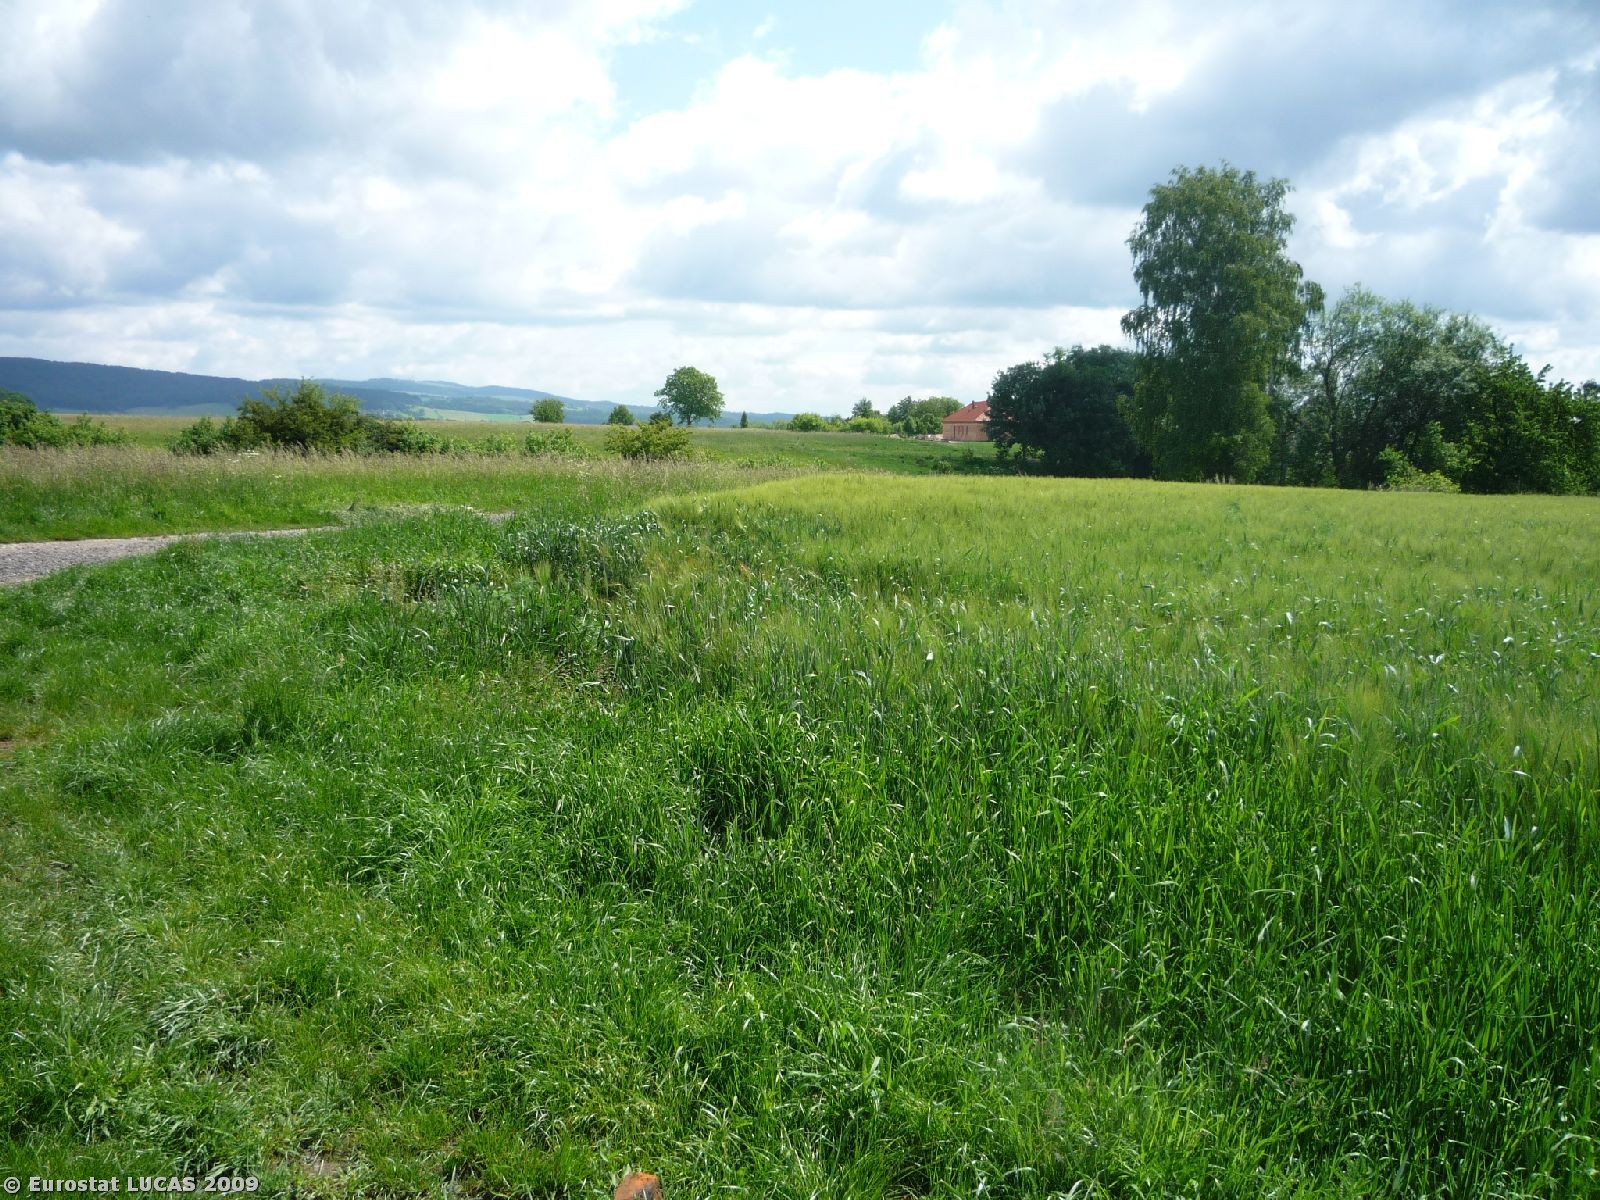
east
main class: Cropland
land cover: Barley
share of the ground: > 75 %
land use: Agriculture (excluding fallow land and kitchen gardens)
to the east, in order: Barley; Grass margins; Tracks; Grassland without tree/shrub cover; Paved roads, cycling and walking lanes; Grassland without tree/shrub cover; Broadleaved woodland; Grassland without tree/shrub cover; Ditches and canals; Grassland without tree/shrub cover
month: June
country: CZ
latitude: 50.4283
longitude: 15.5365
